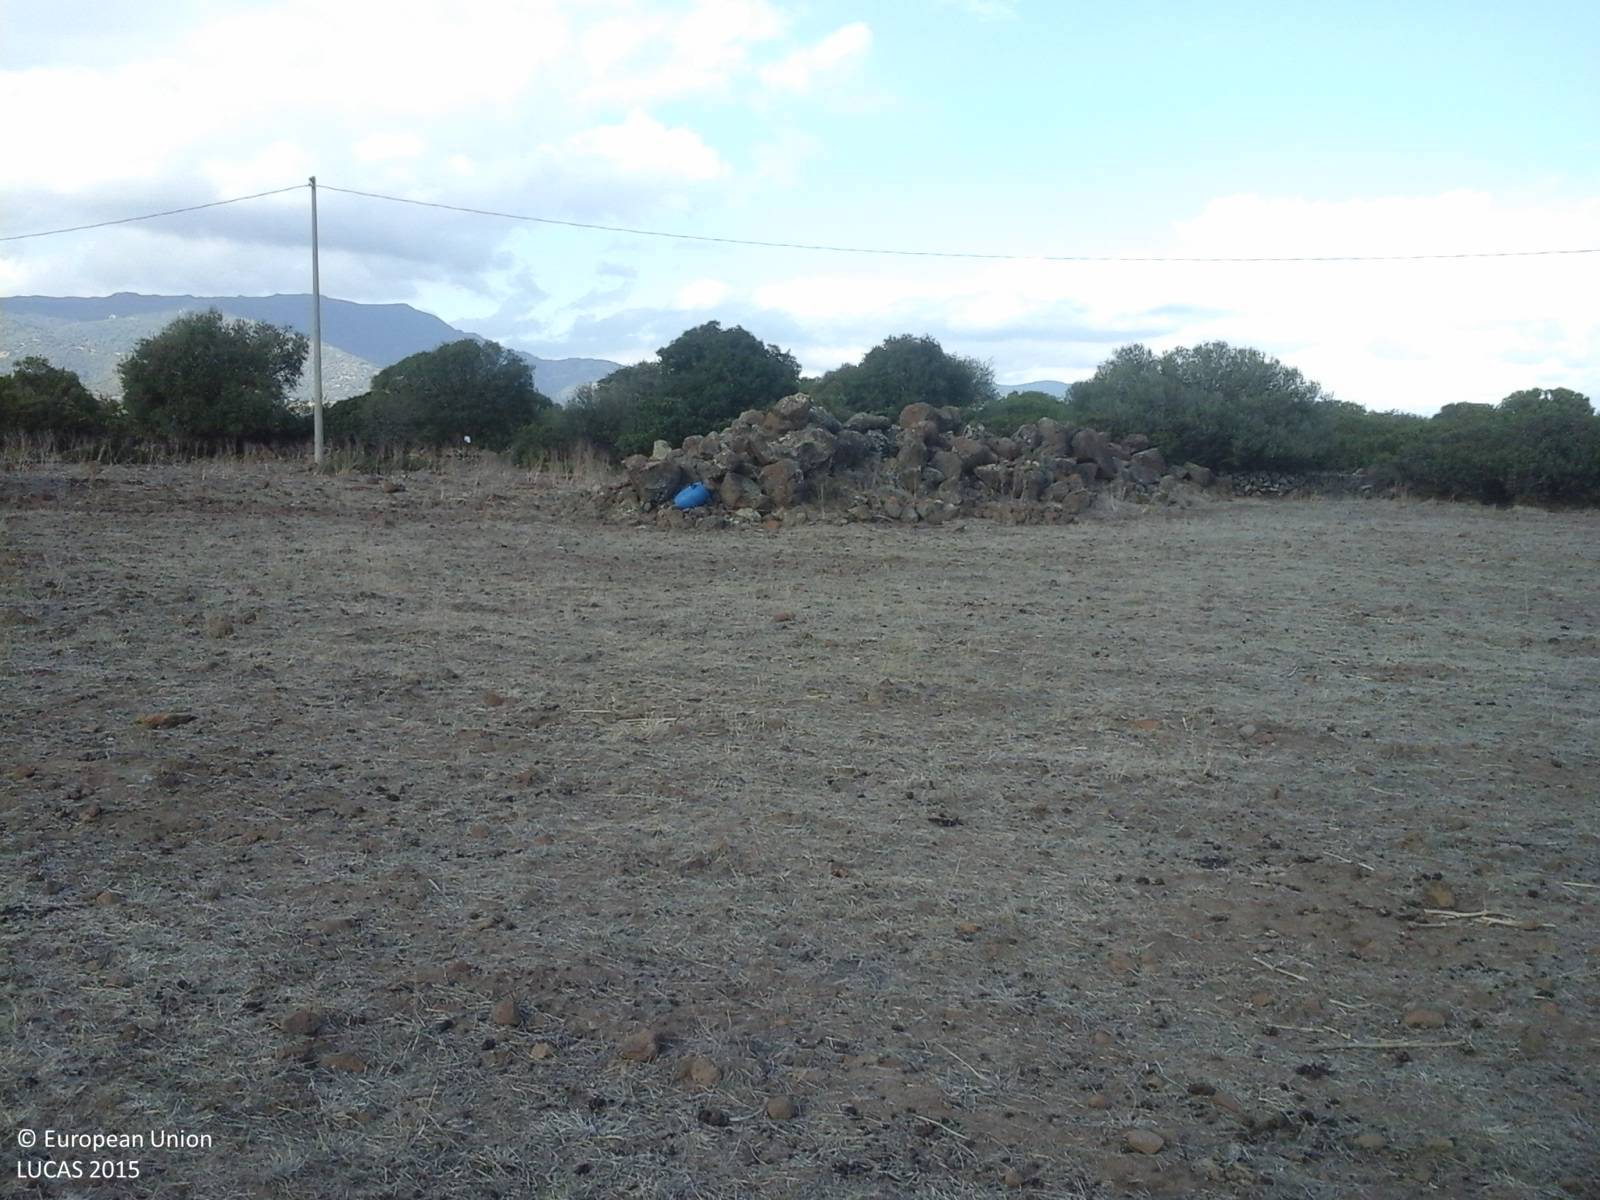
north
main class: Grassland
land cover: Grassland without tree/shrub cover
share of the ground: > 75 %
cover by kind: herbaceous plants 100 %
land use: Agriculture (excluding fallow land and kitchen gardens)
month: September
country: IT
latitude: 40.2613
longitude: 8.9122
